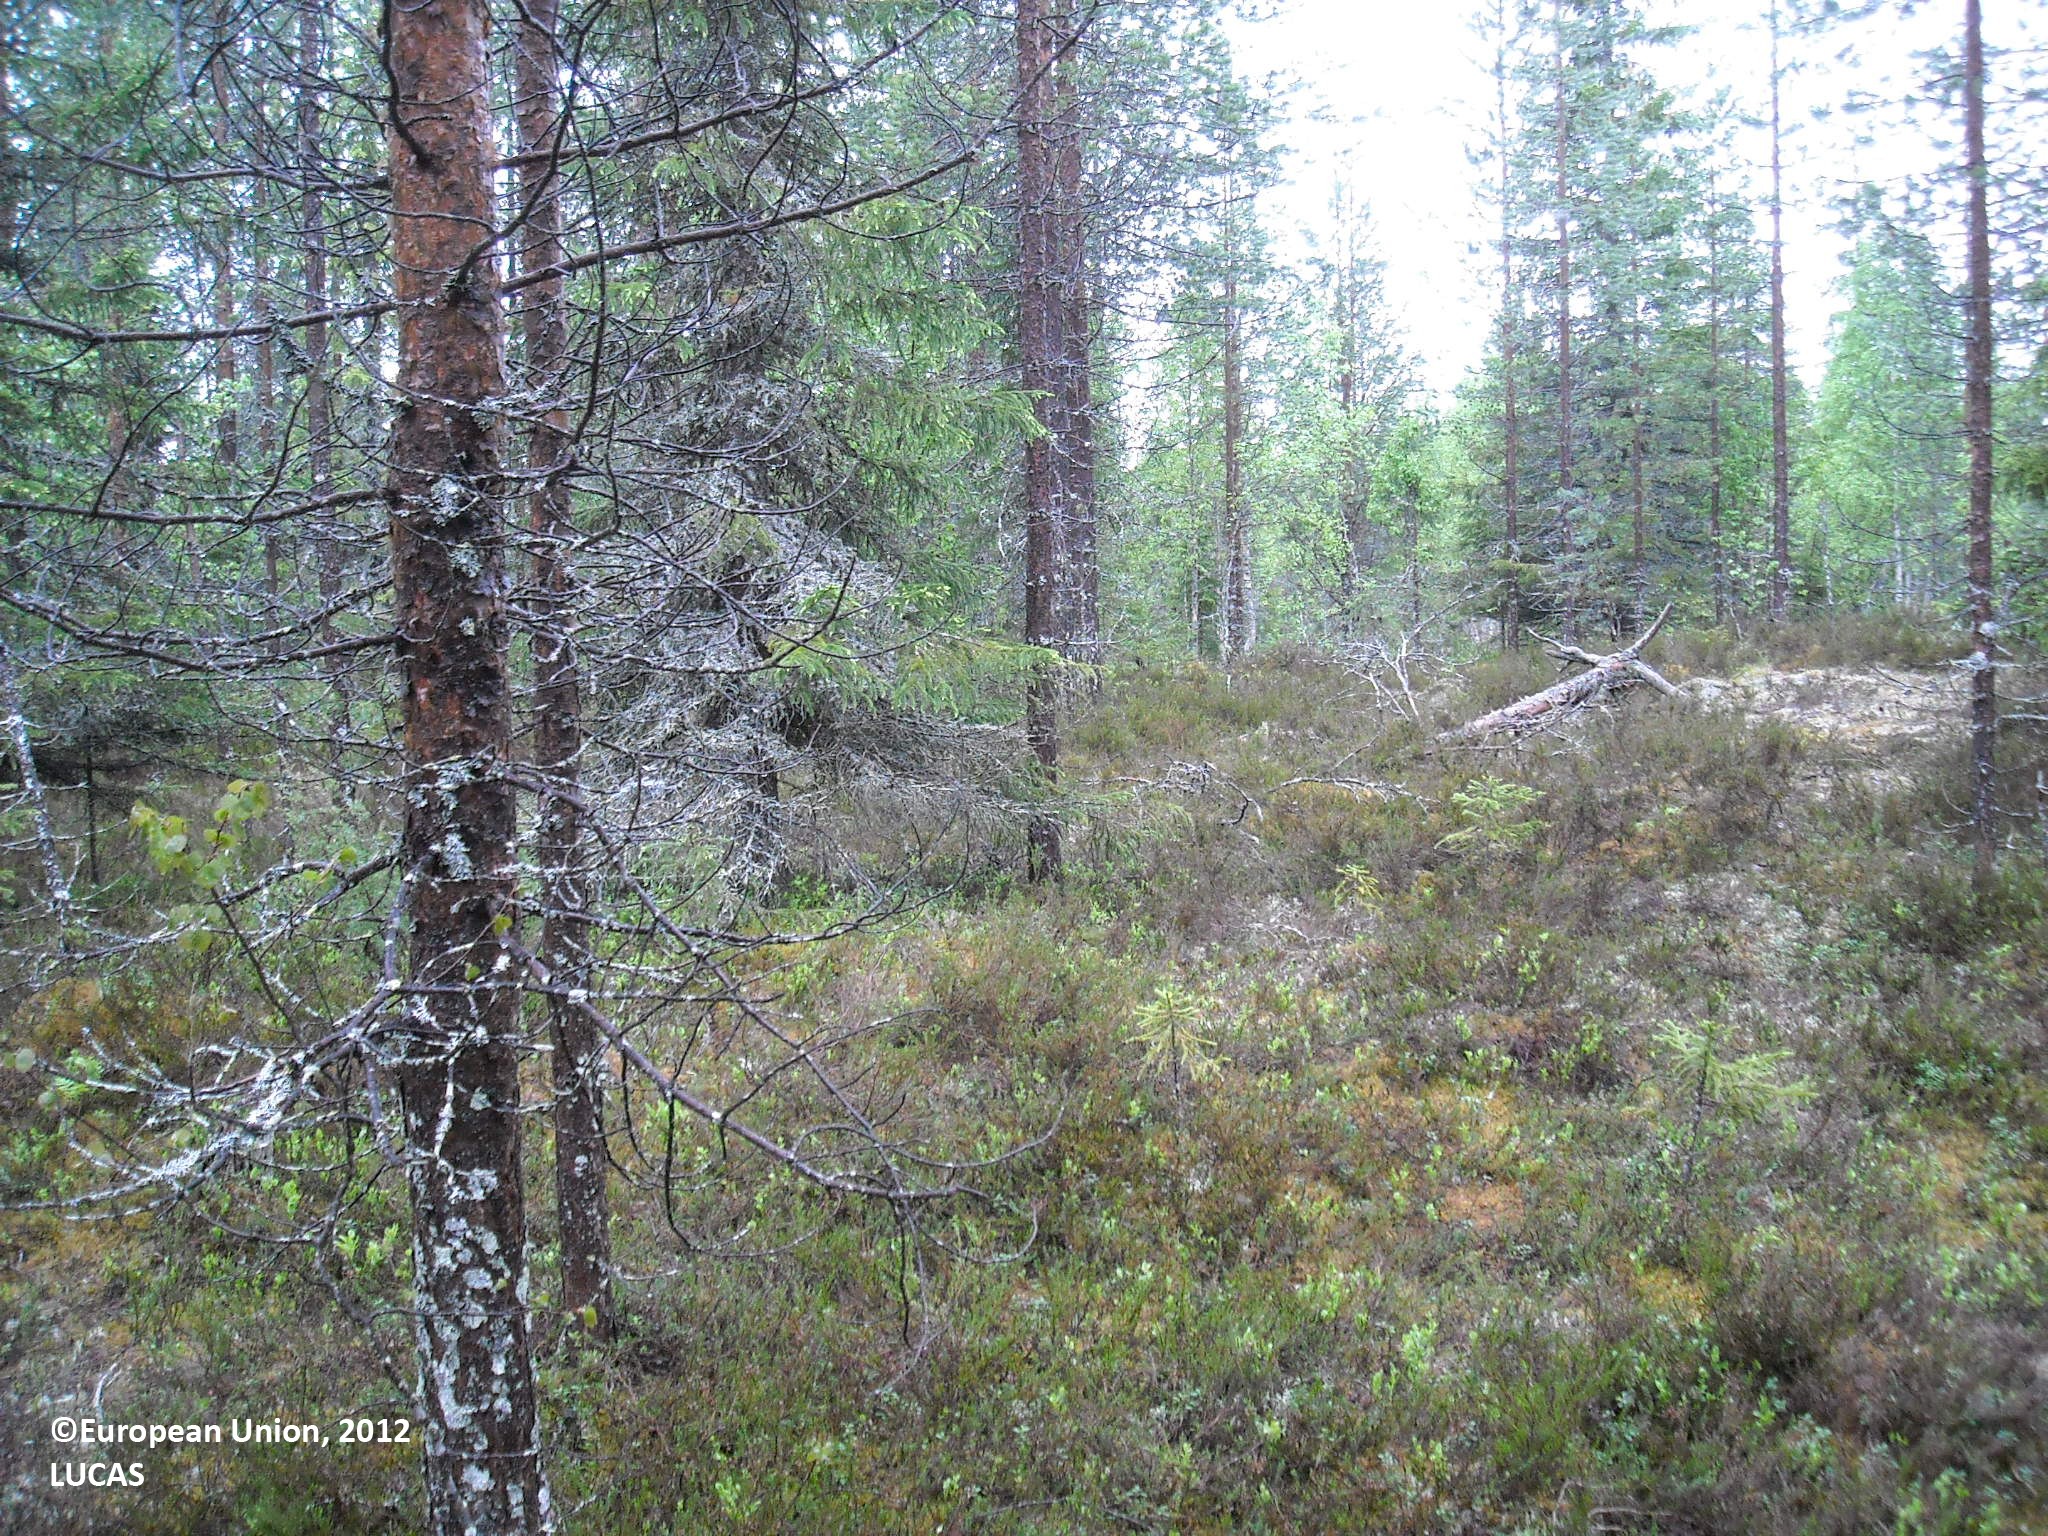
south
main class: Woodland
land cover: Other coniferous woodland
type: boreal forest
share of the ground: > 75 %
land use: Forestry
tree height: > 5 m
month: June
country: FI
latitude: 65.6255
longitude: 27.8808
